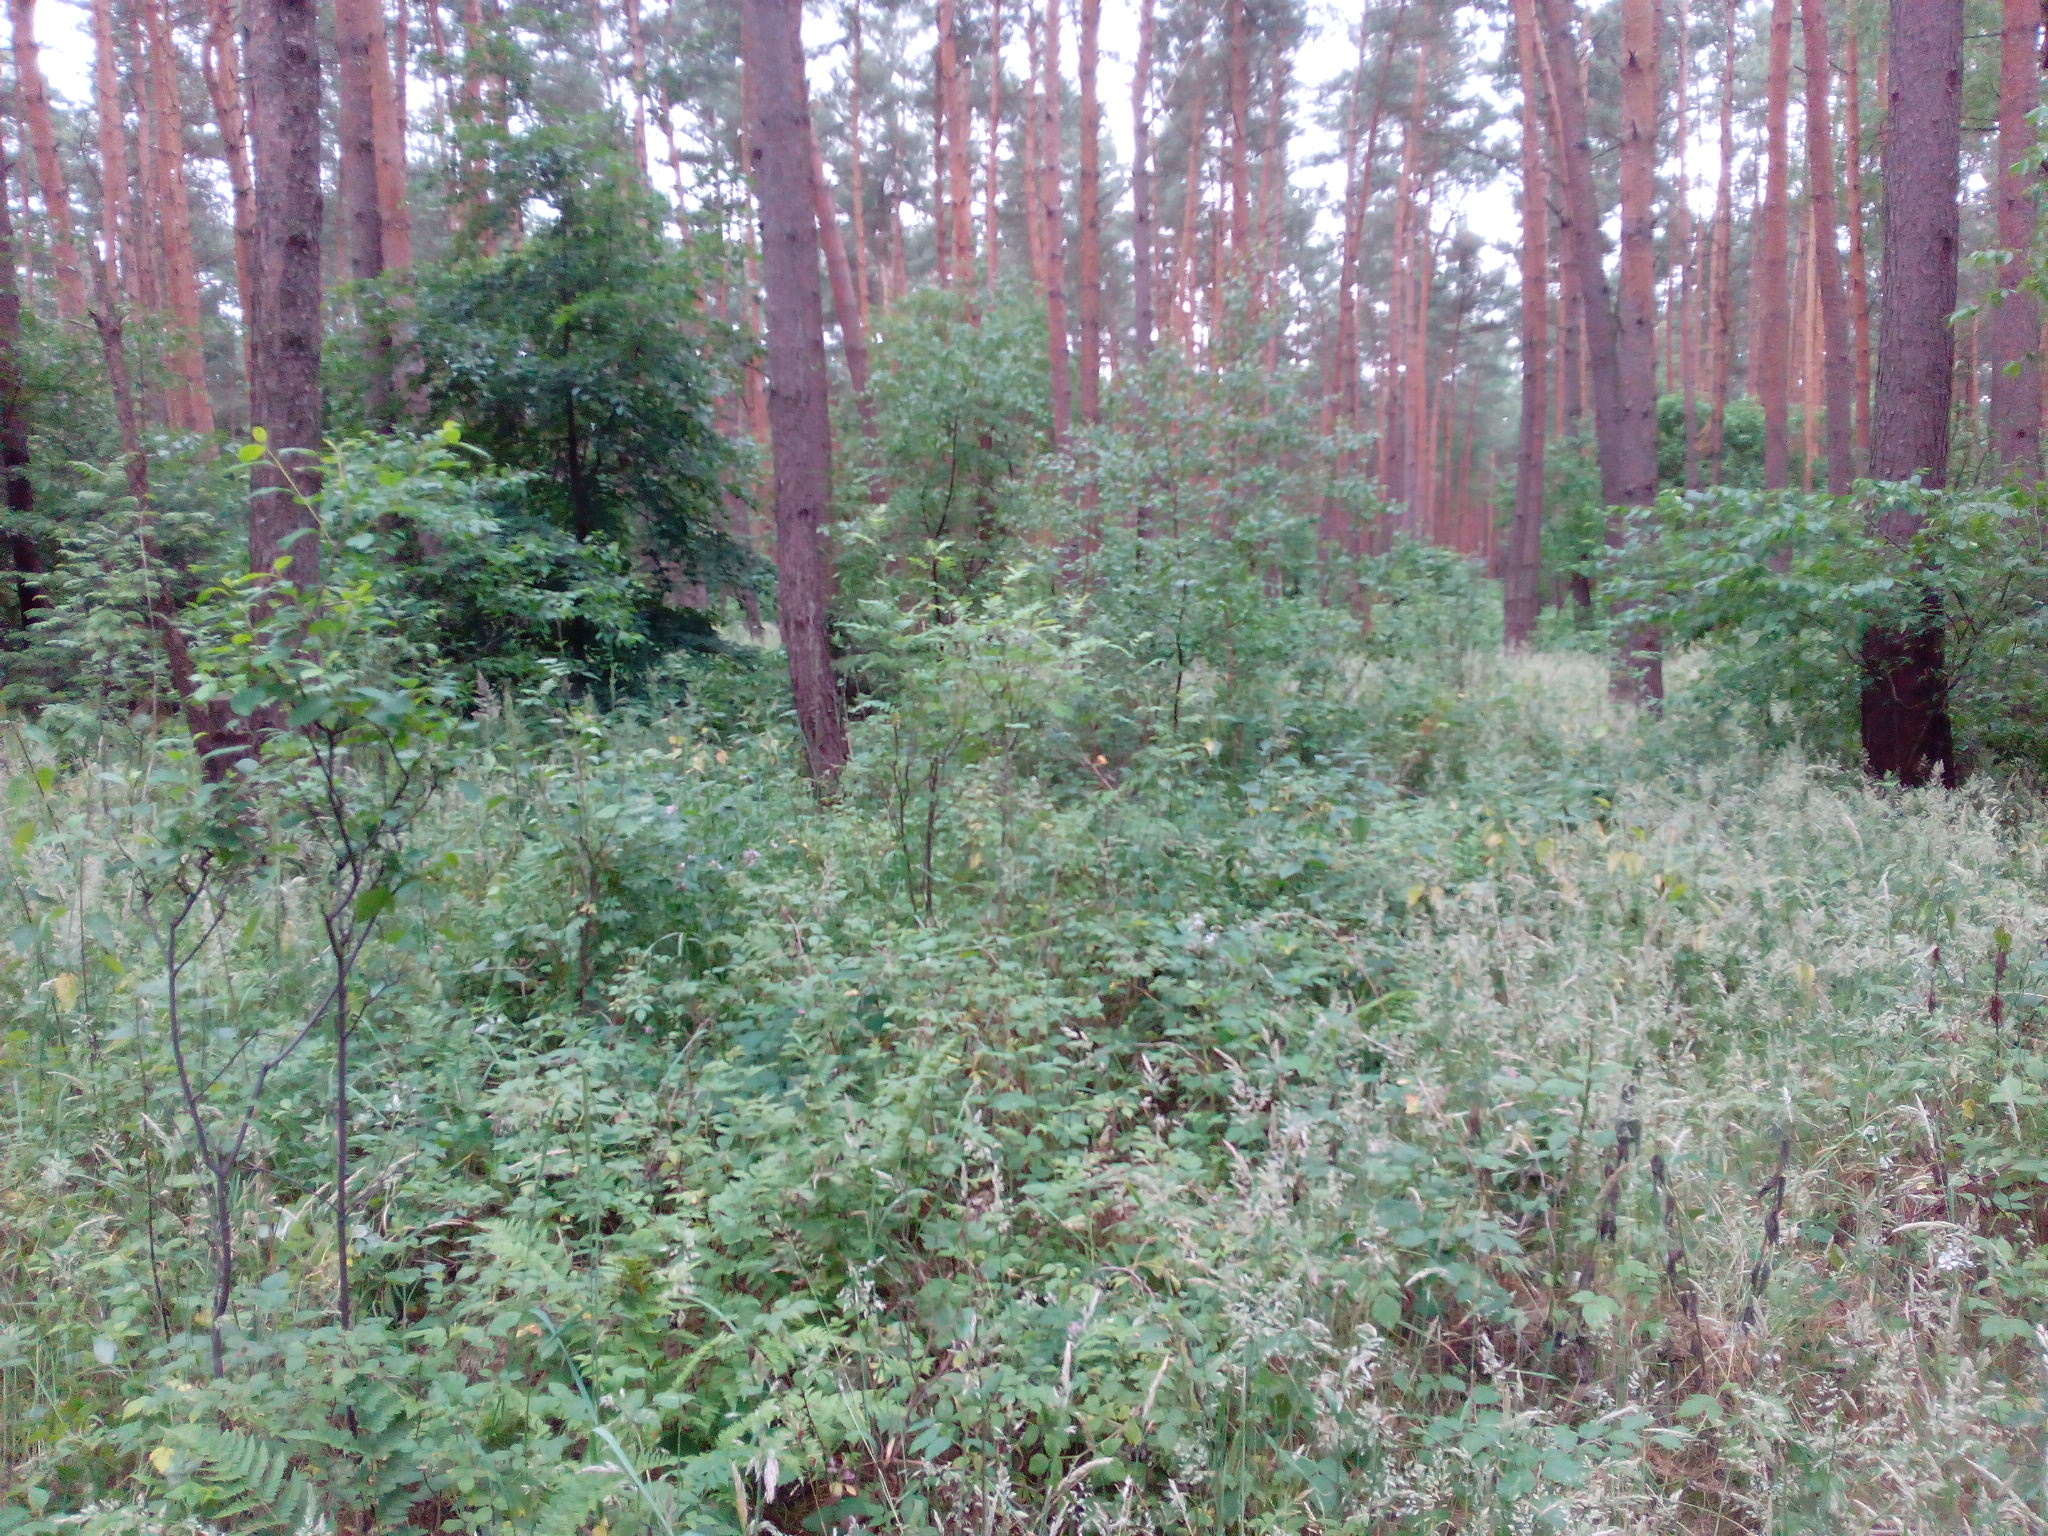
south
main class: Woodland
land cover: Pine dominated coniferous woodland
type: hemiboreal forest and nemoral coniferous forest and mixed broadleaved-coniferous forest
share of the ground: > 75 %
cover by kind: coniferous forest trees 80 %, herbaceous plants 10 %, broadleaved forest trees 5 %, shrubs 5 %
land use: Forestry
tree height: > 5 m
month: June
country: DE
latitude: 52.6110
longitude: 9.8671
